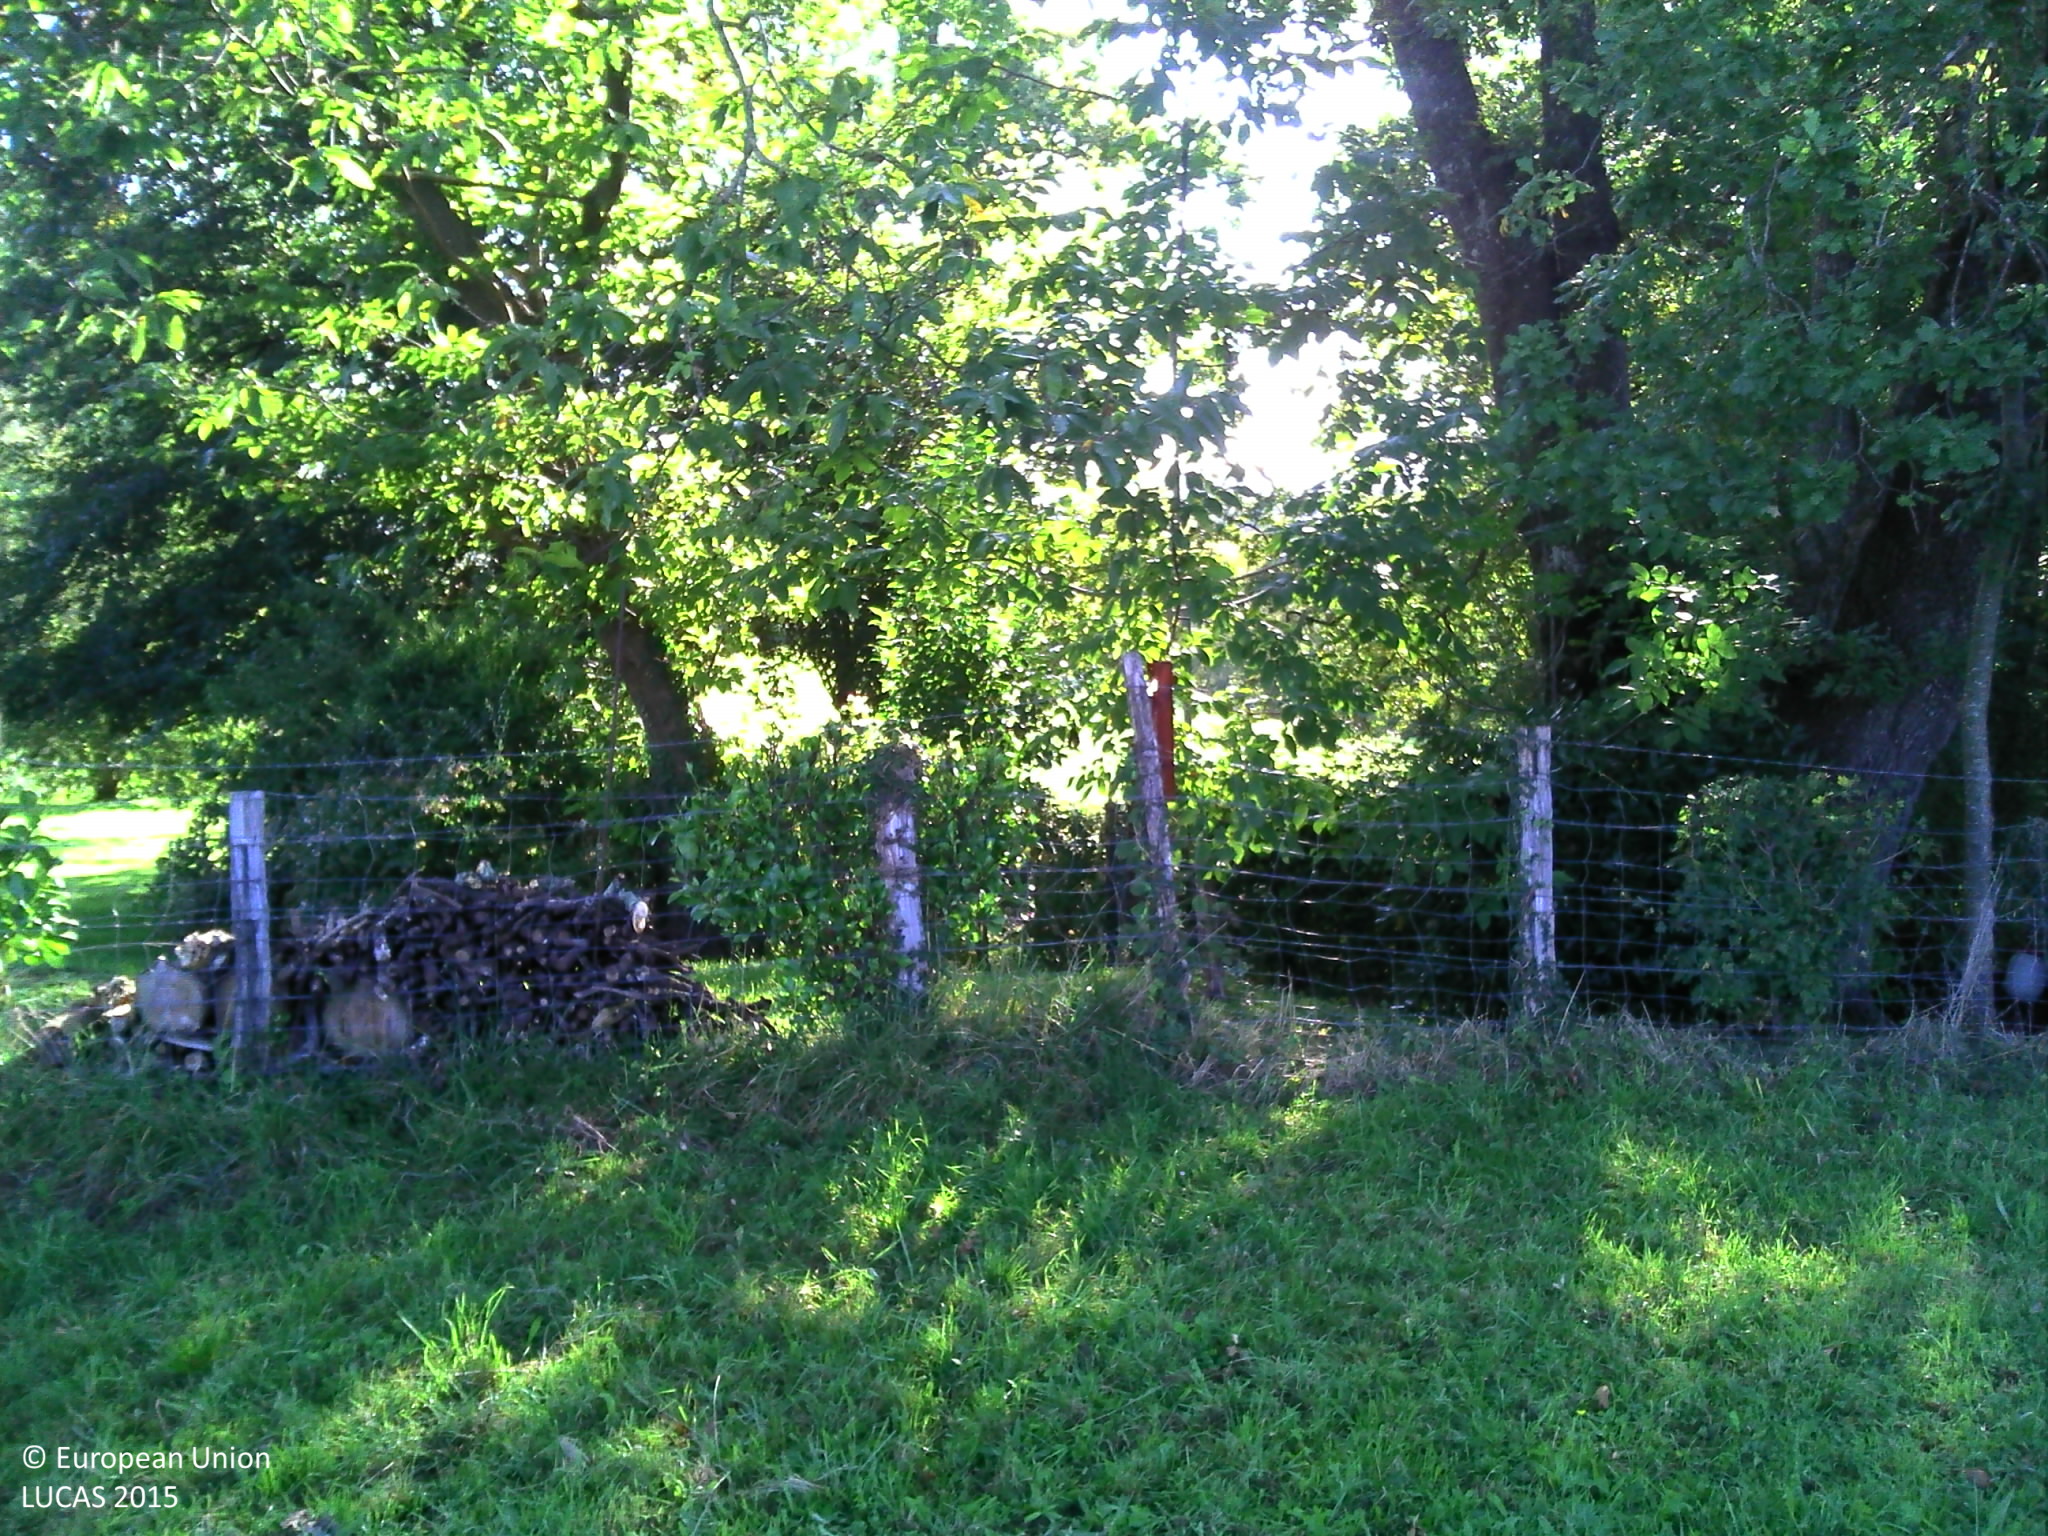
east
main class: Grassland
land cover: Grassland without tree/shrub cover
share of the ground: > 75 %
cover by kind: herbaceous plants 100 %
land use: Agriculture (excluding fallow land and kitchen gardens)
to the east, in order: Grassland without tree/shrub cover; Fences; Broadleaved woodland; Fences; Broadleaved woodland; Electric lines; Paved roads, cycling and walking lanes; Fences; Broadleaved woodland; Grassland without tree/shrub cover; Managed hedges; Fences; Grassland without tree/shrub cover
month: September
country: FR
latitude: 43.1414
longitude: -0.3455
